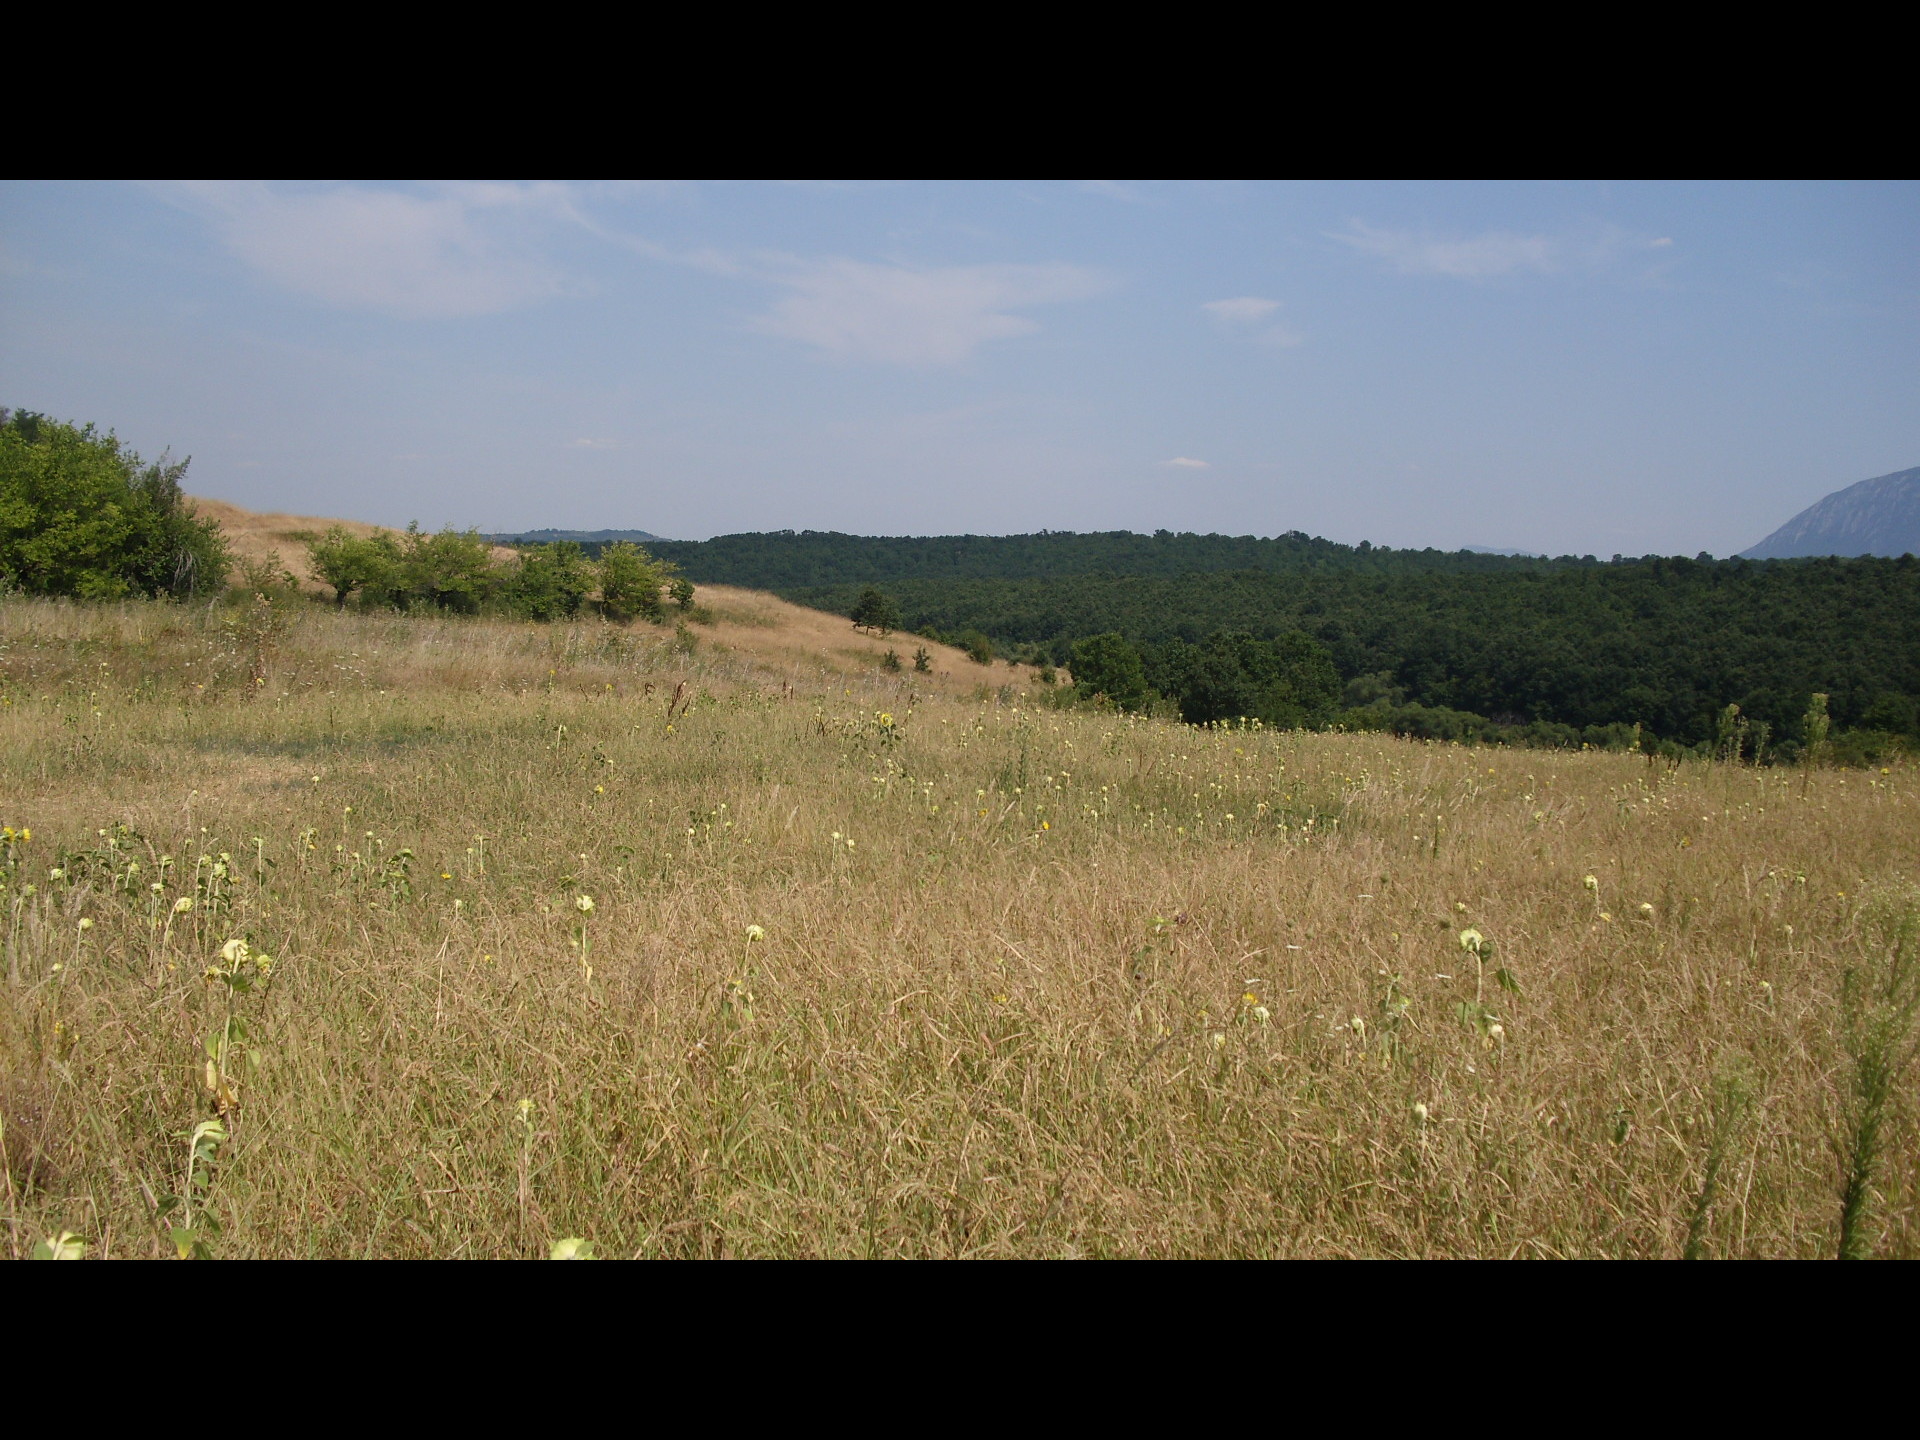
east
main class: Grassland
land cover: Spontaneously vegetated surfaces
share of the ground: > 75 %
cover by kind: herbaceous plants 100 %
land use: Agriculture (excluding fallow land and kitchen gardens)
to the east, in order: Spontaneously vegetated surfaces; Tracks; Grassland with sparse tree/shrub cover; Shrubland without tree cover; Grassland with sparse tree/shrub cover; Ditches and canals; Grassland with sparse tree/shrub cover; Grassland without tree/shrub cover
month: August
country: BG
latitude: 43.3116
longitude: 23.2686
